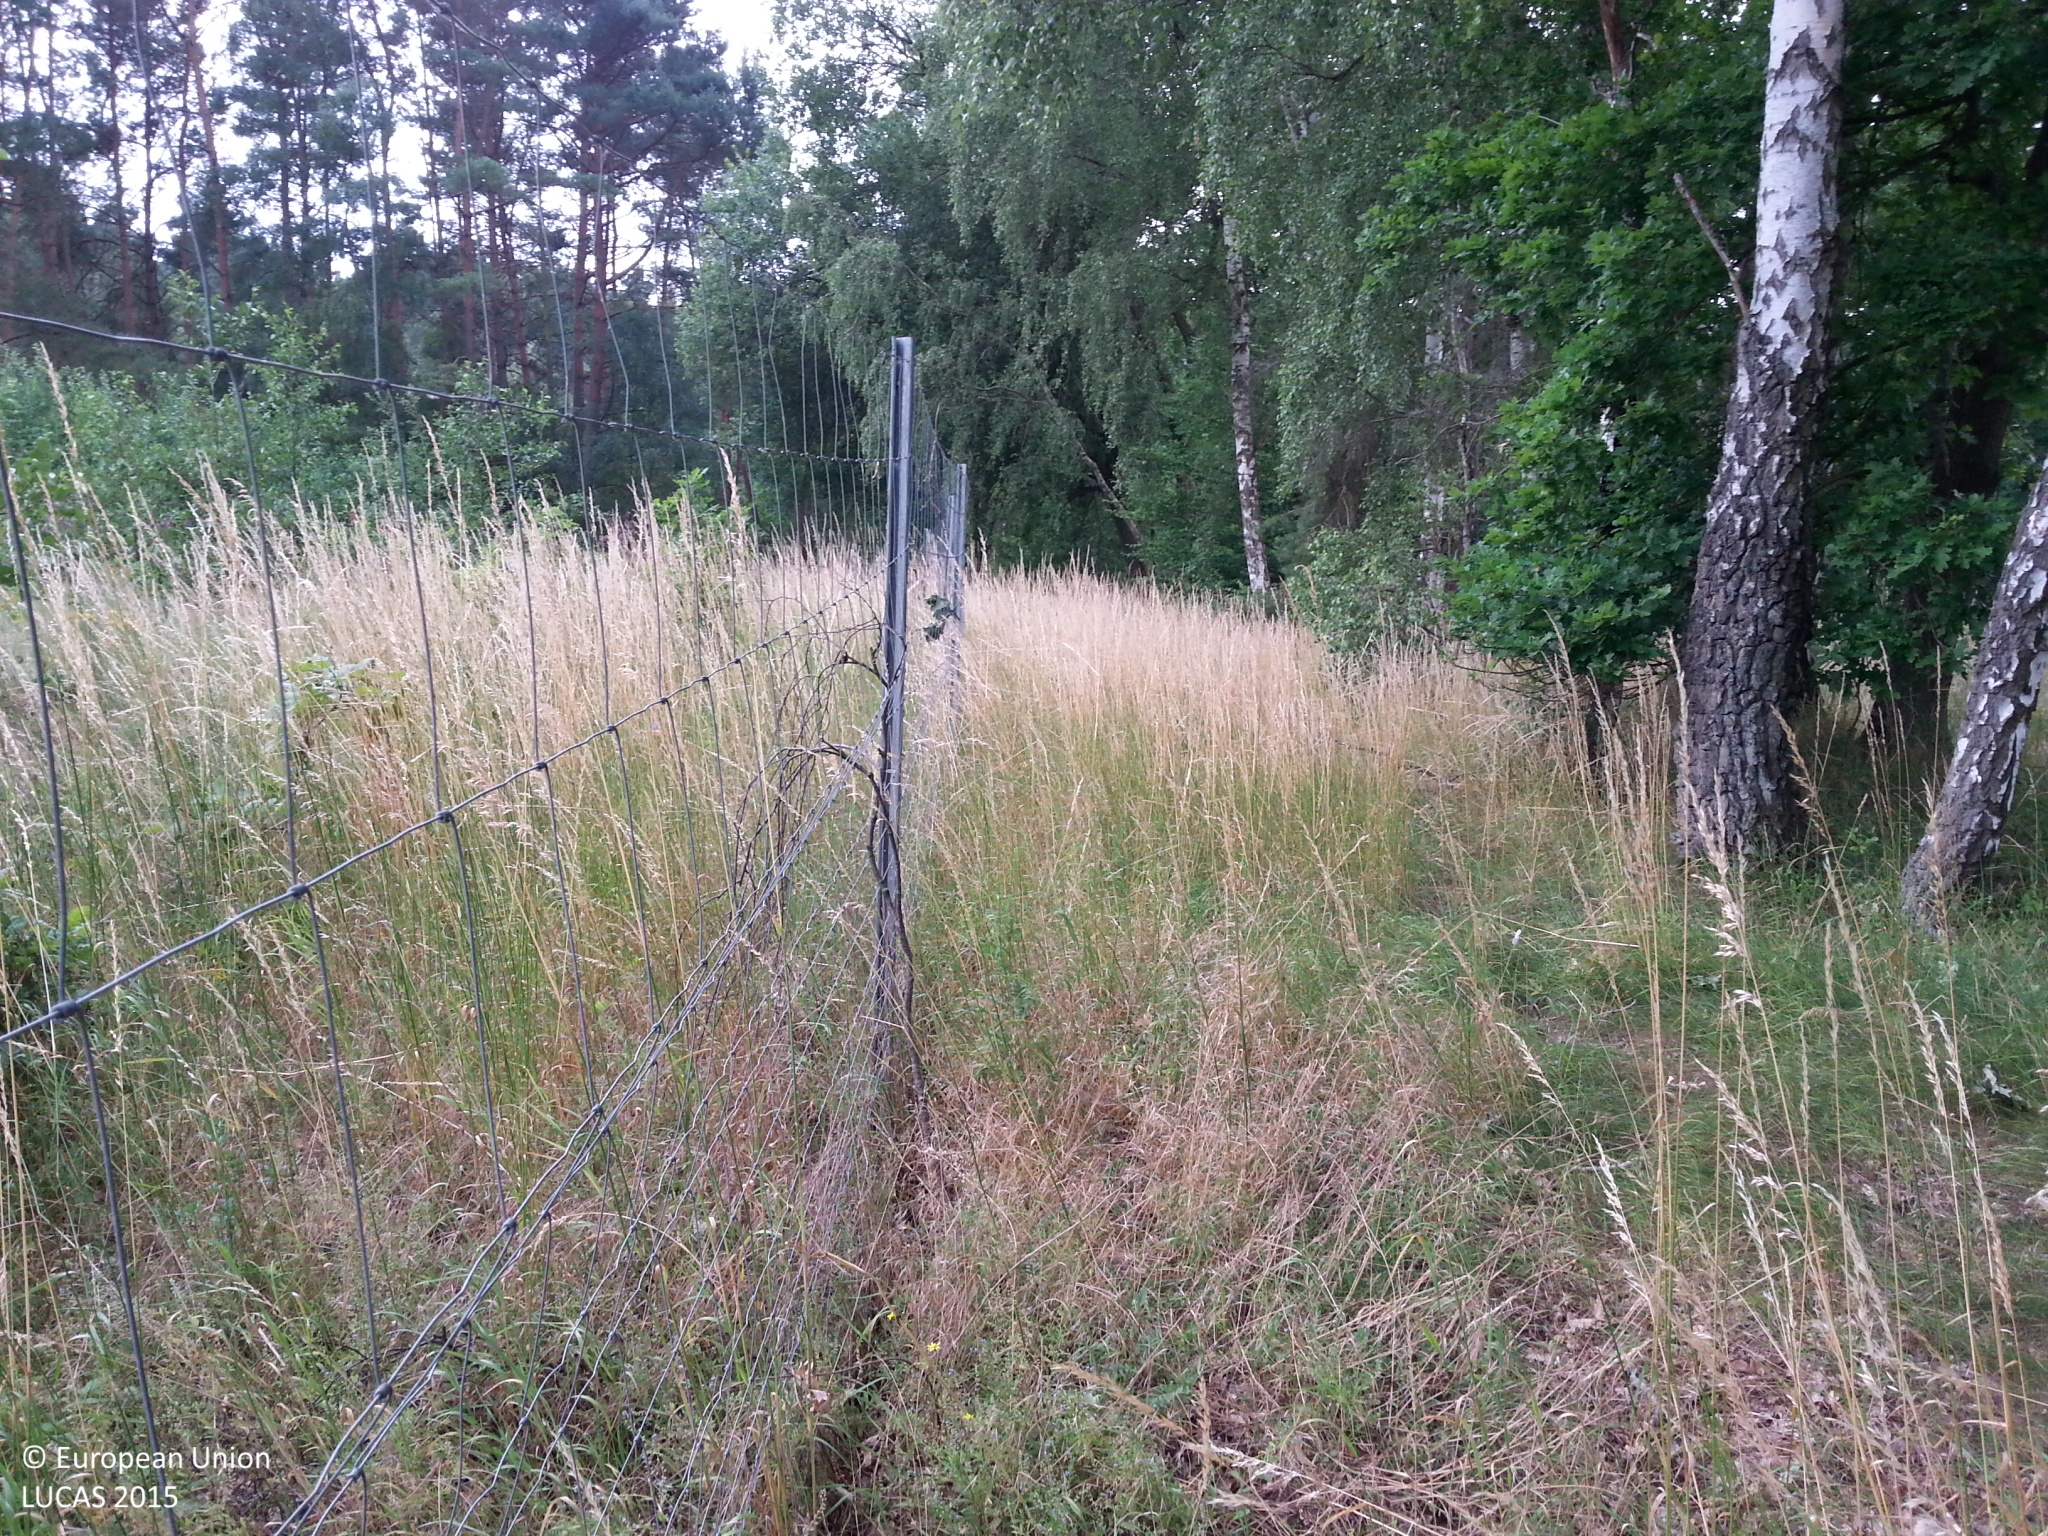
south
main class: Woodland
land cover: Broadleaved woodland
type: acidophilous oak and oak-birch forest
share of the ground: 25 - 50 %
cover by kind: herbaceous plants 45 %, shrubs 30 %, broadleaved forest trees 25 %
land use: Forestry
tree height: < 5 m
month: July
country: DE
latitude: 53.7869
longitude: 11.5930
